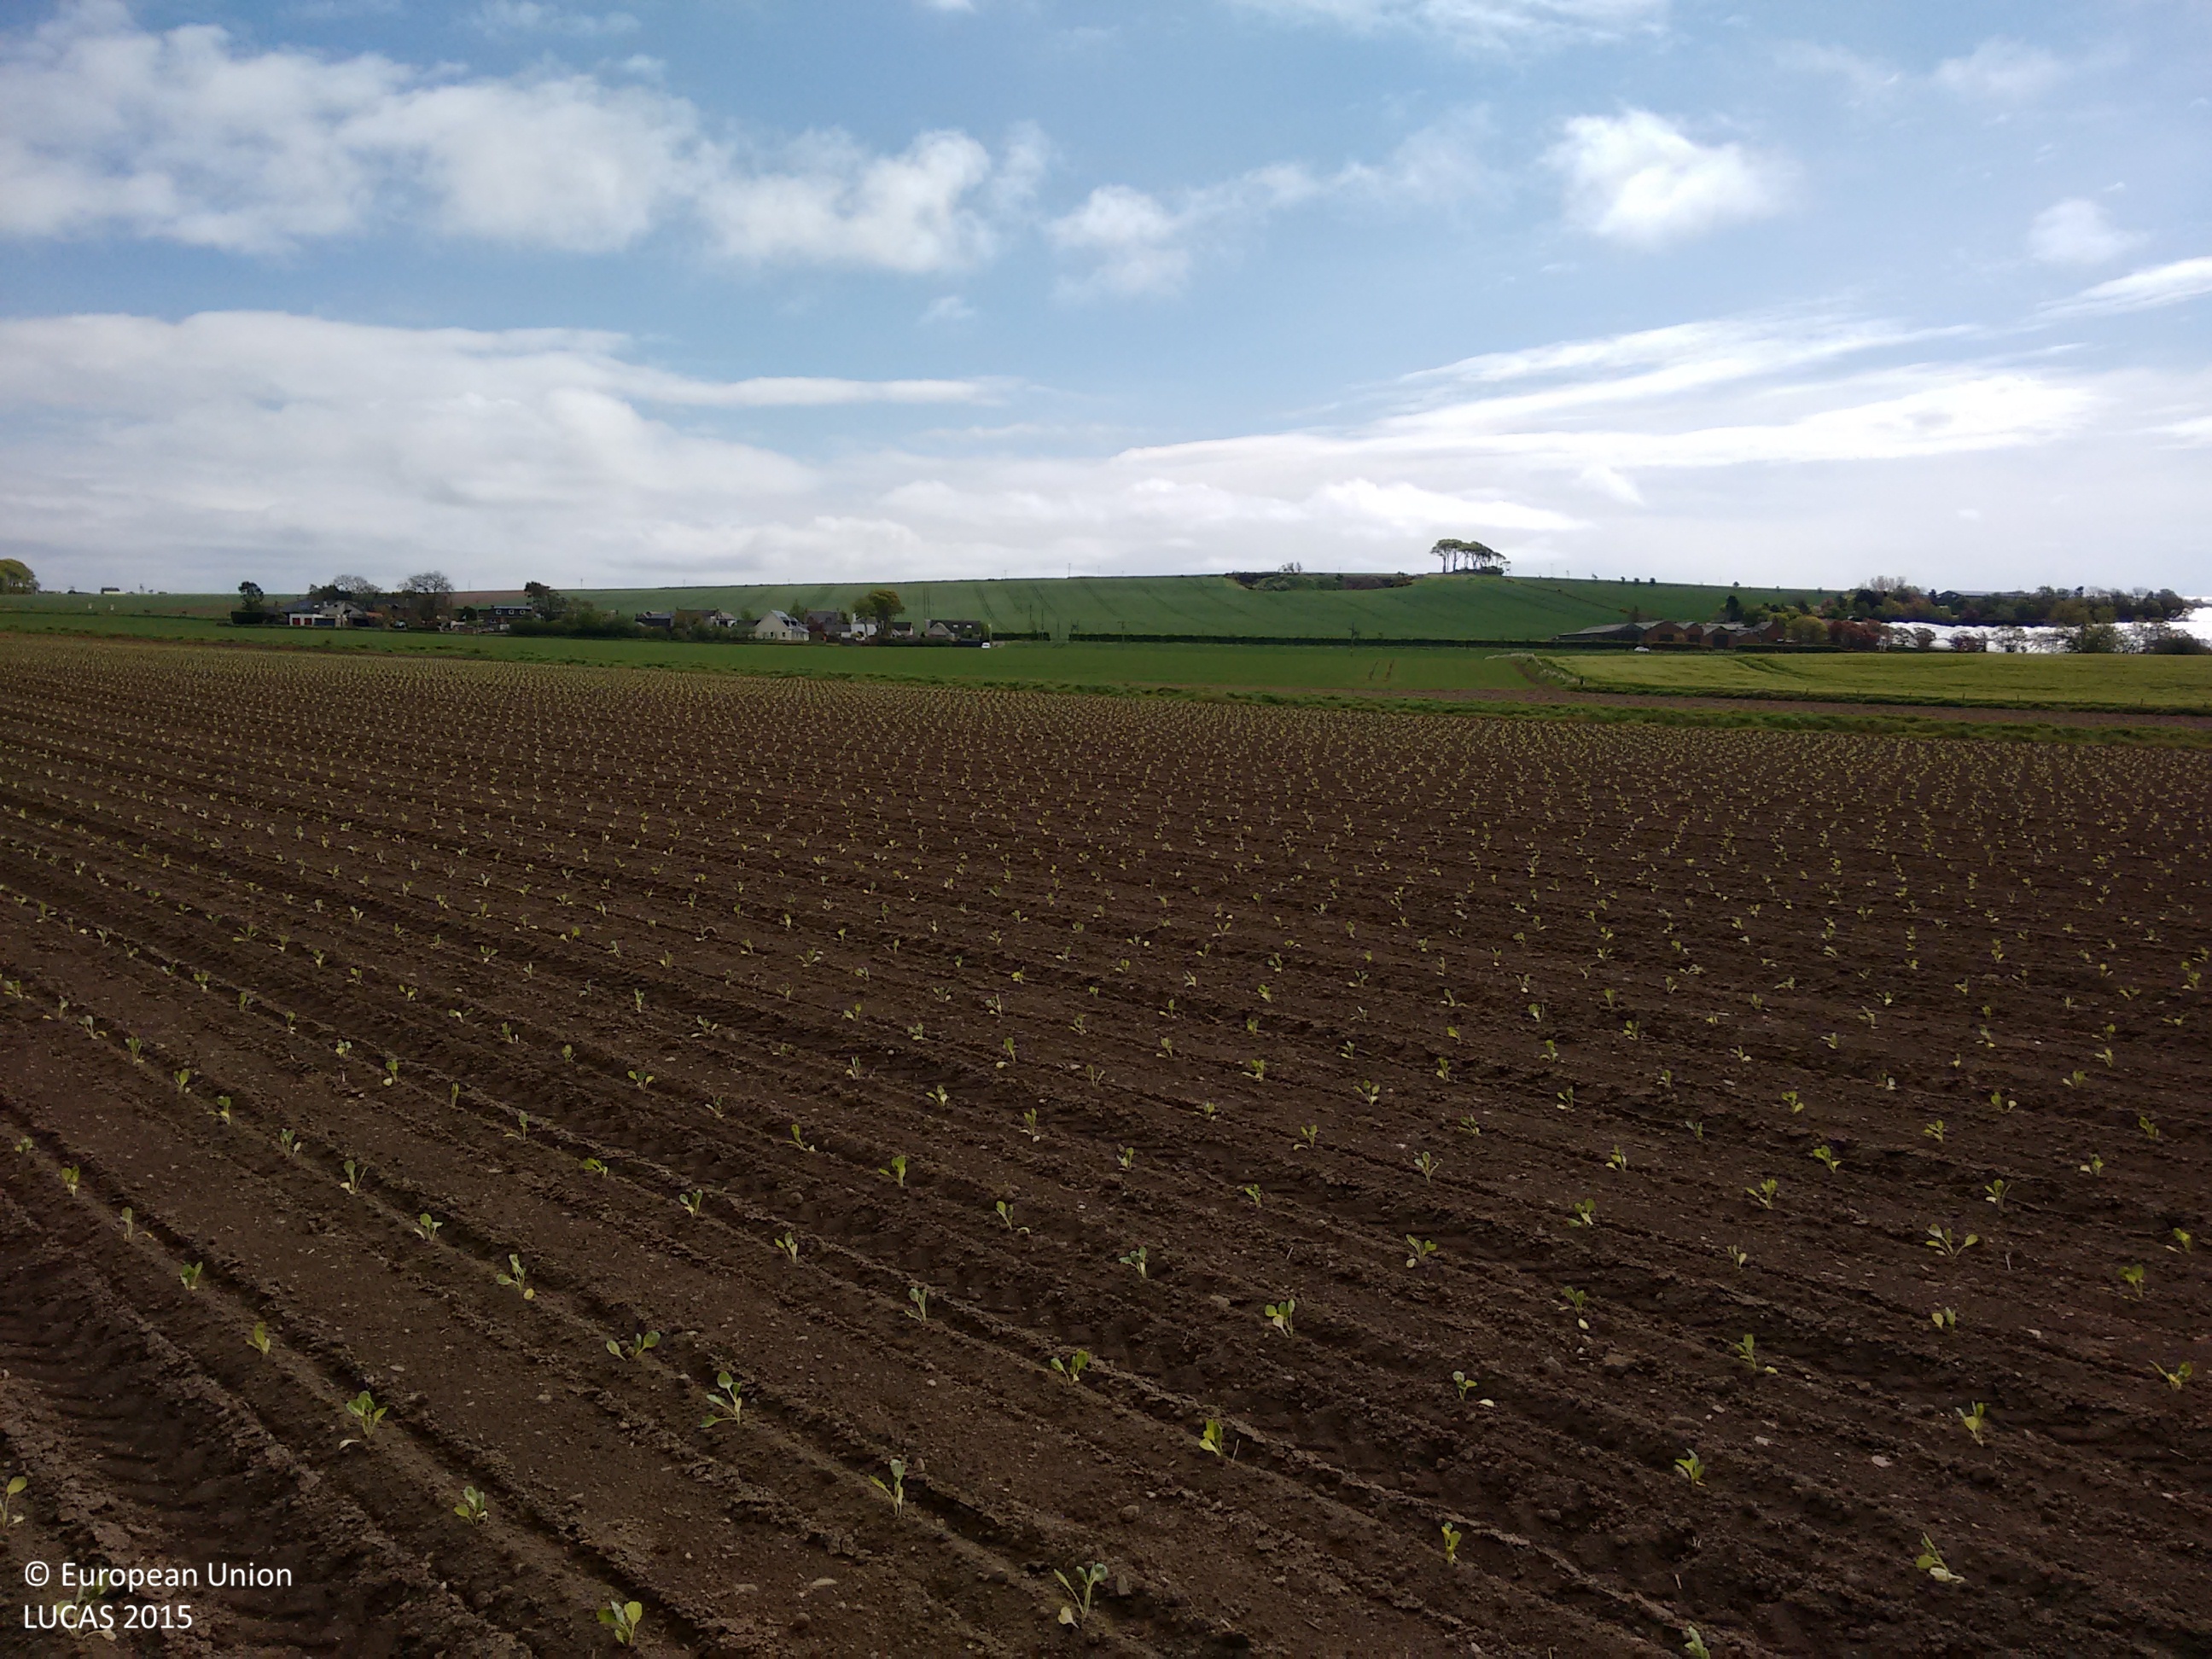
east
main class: Cropland
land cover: Other fresh vegetables
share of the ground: < 10 %
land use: Agriculture (excluding fallow land and kitchen gardens)
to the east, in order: Other fresh vegetables; Grass margins; Ditches and canals; Grass margins; Other bare soil; Barley
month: May
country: GB
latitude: 56.5862
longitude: -2.5793
